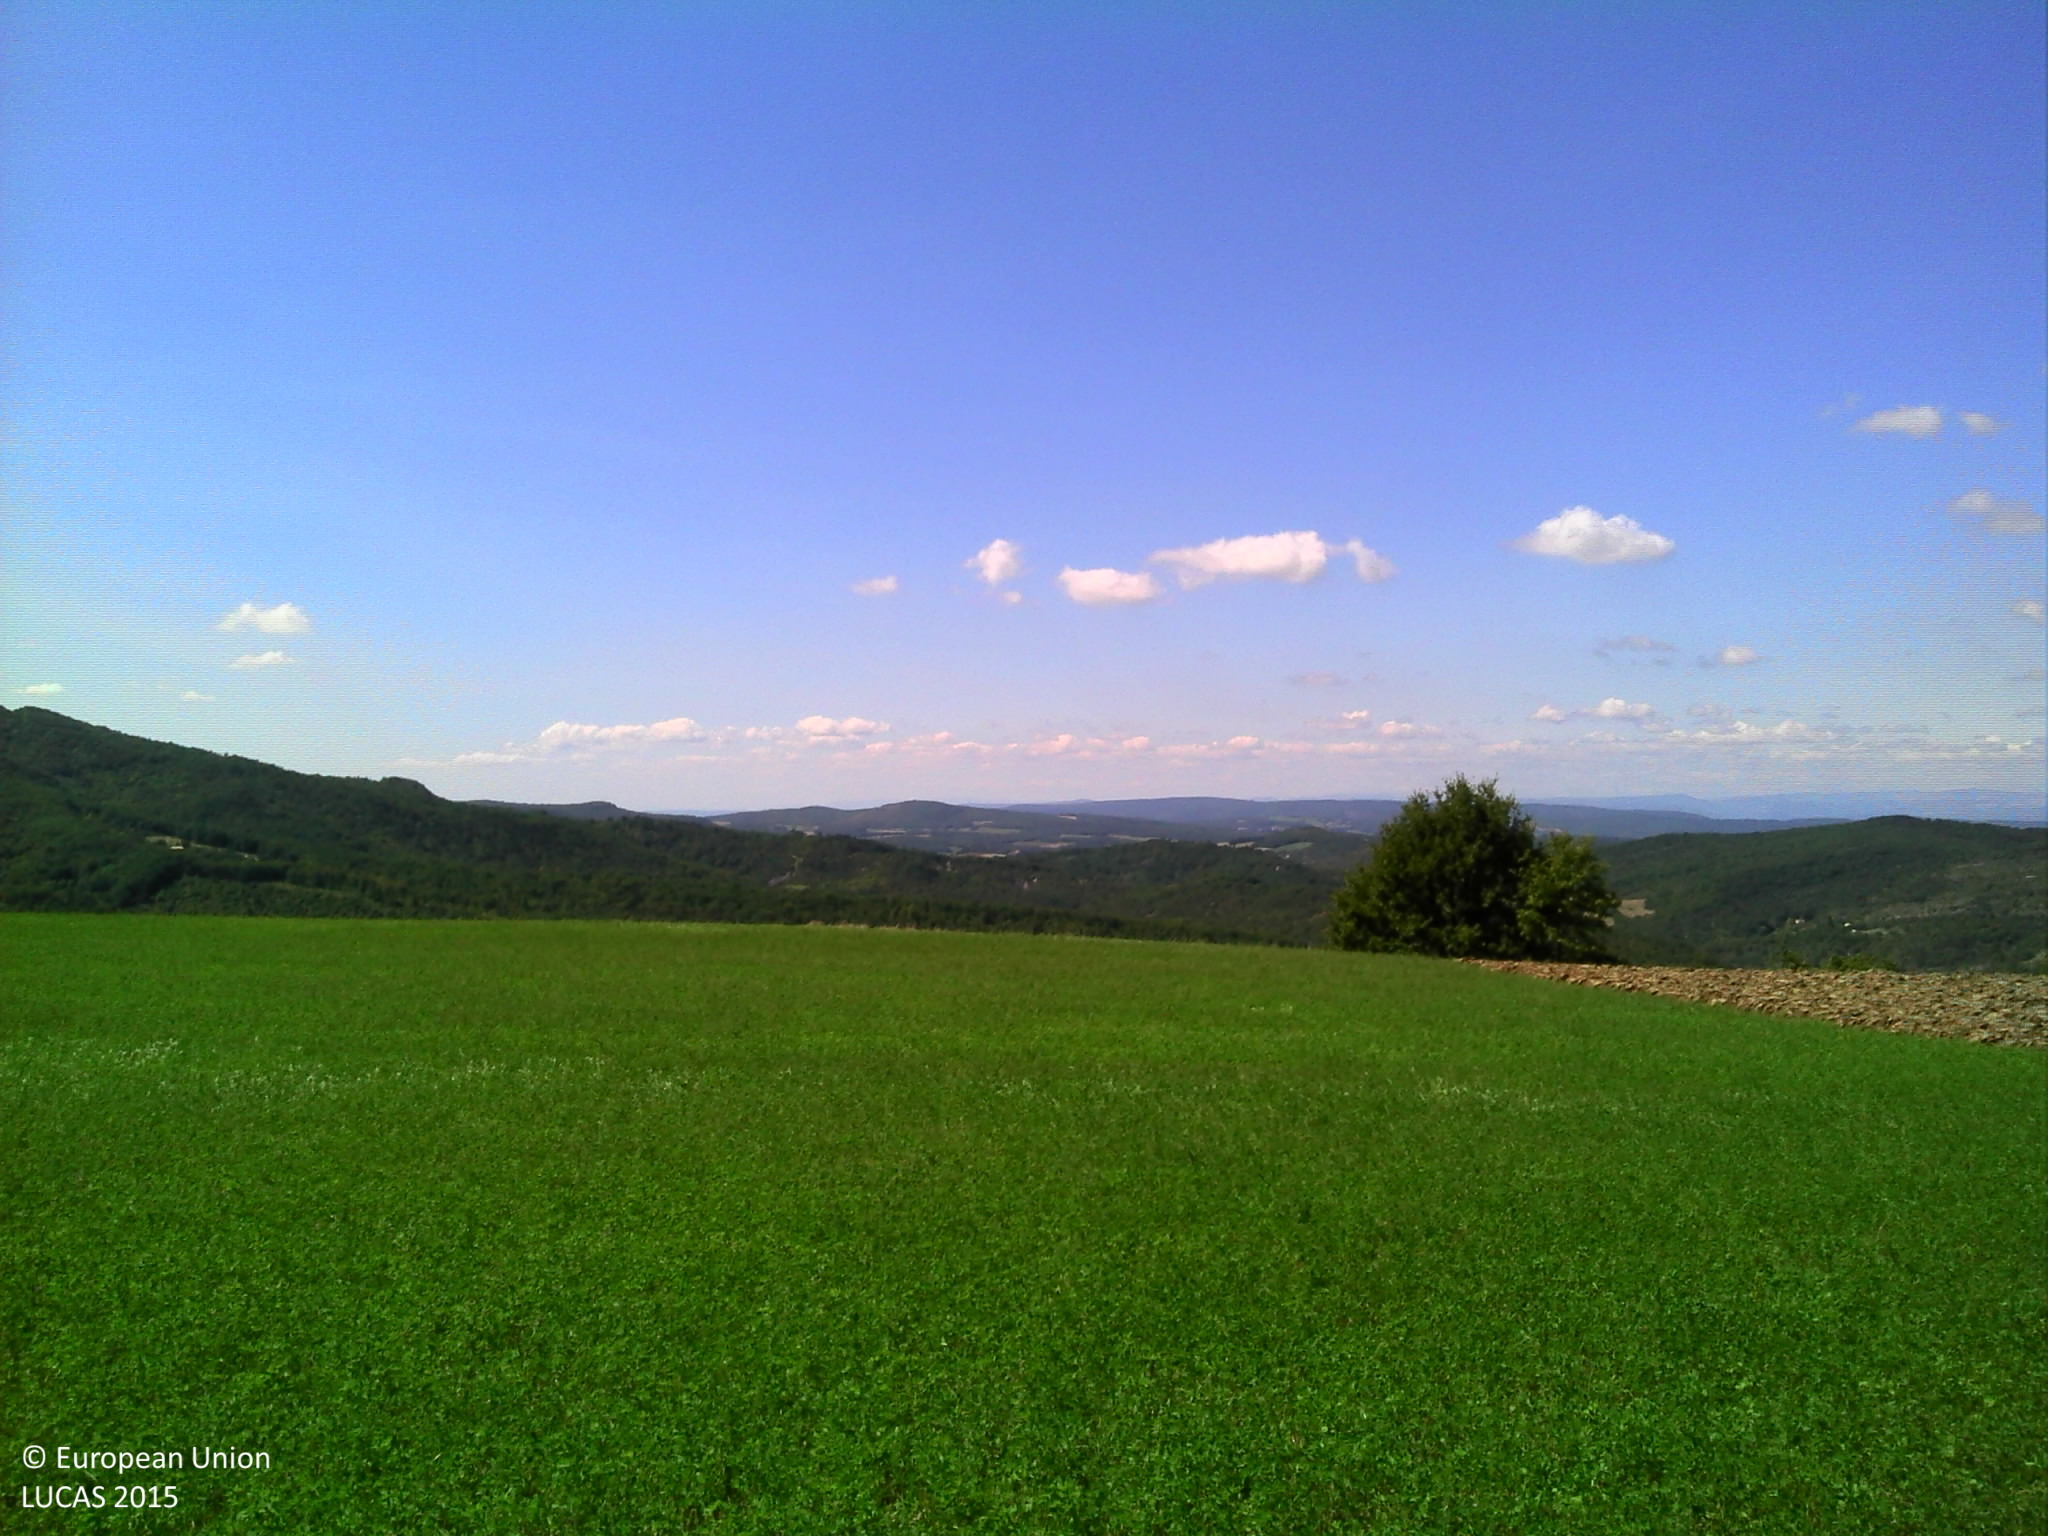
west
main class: Cropland
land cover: Lucerne
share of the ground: > 75 %
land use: Agriculture (excluding fallow land and kitchen gardens)
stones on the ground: 25 - 50 %
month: September
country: FR
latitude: 44.6852
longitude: 5.0733
